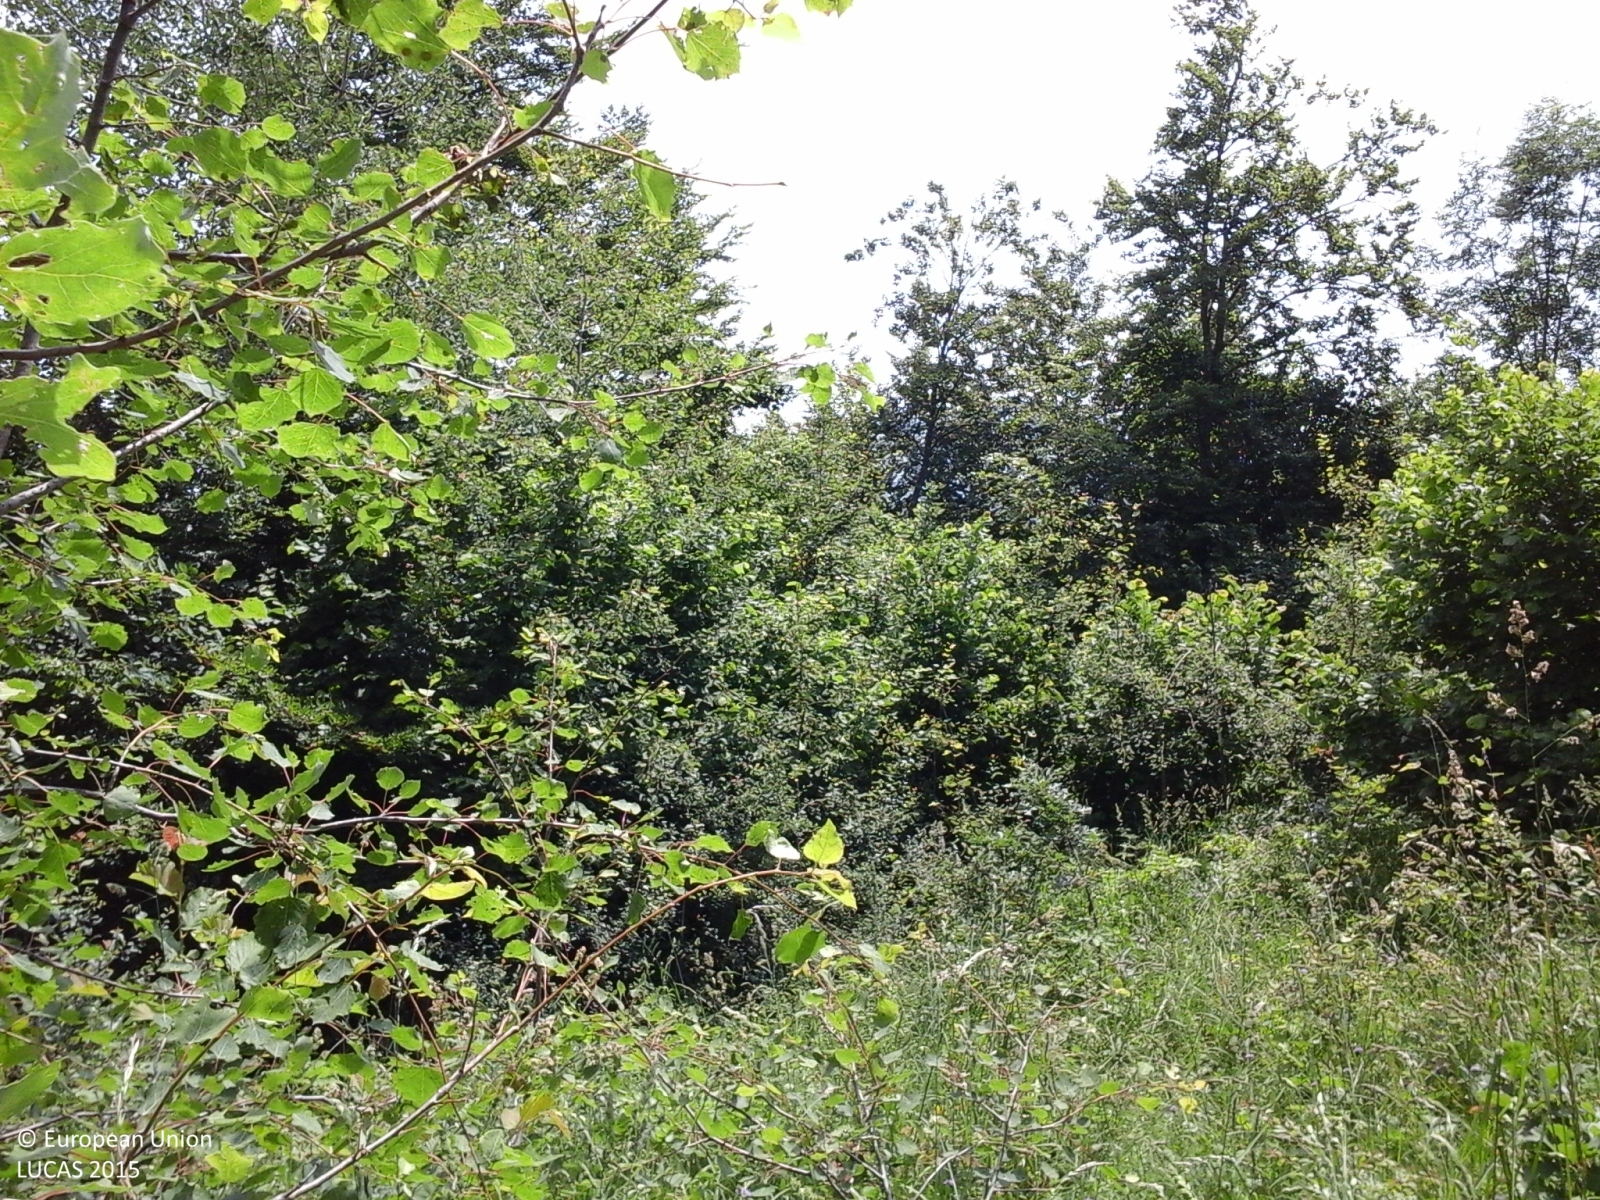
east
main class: Grassland
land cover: Grassland without tree/shrub cover
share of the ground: > 75 %
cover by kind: herbaceous plants 100 %
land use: Forestry
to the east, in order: Grassland without tree/shrub cover; Broadleaved woodland; Tracks; Shrubland with sparse tree cover; Rivers and streams; Broadleaved woodland; Grassland without tree/shrub cover; Broadleaved woodland; Rivers and streams; Broadleaved woodland
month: June
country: IT
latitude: 44.6927
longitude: 9.6852
